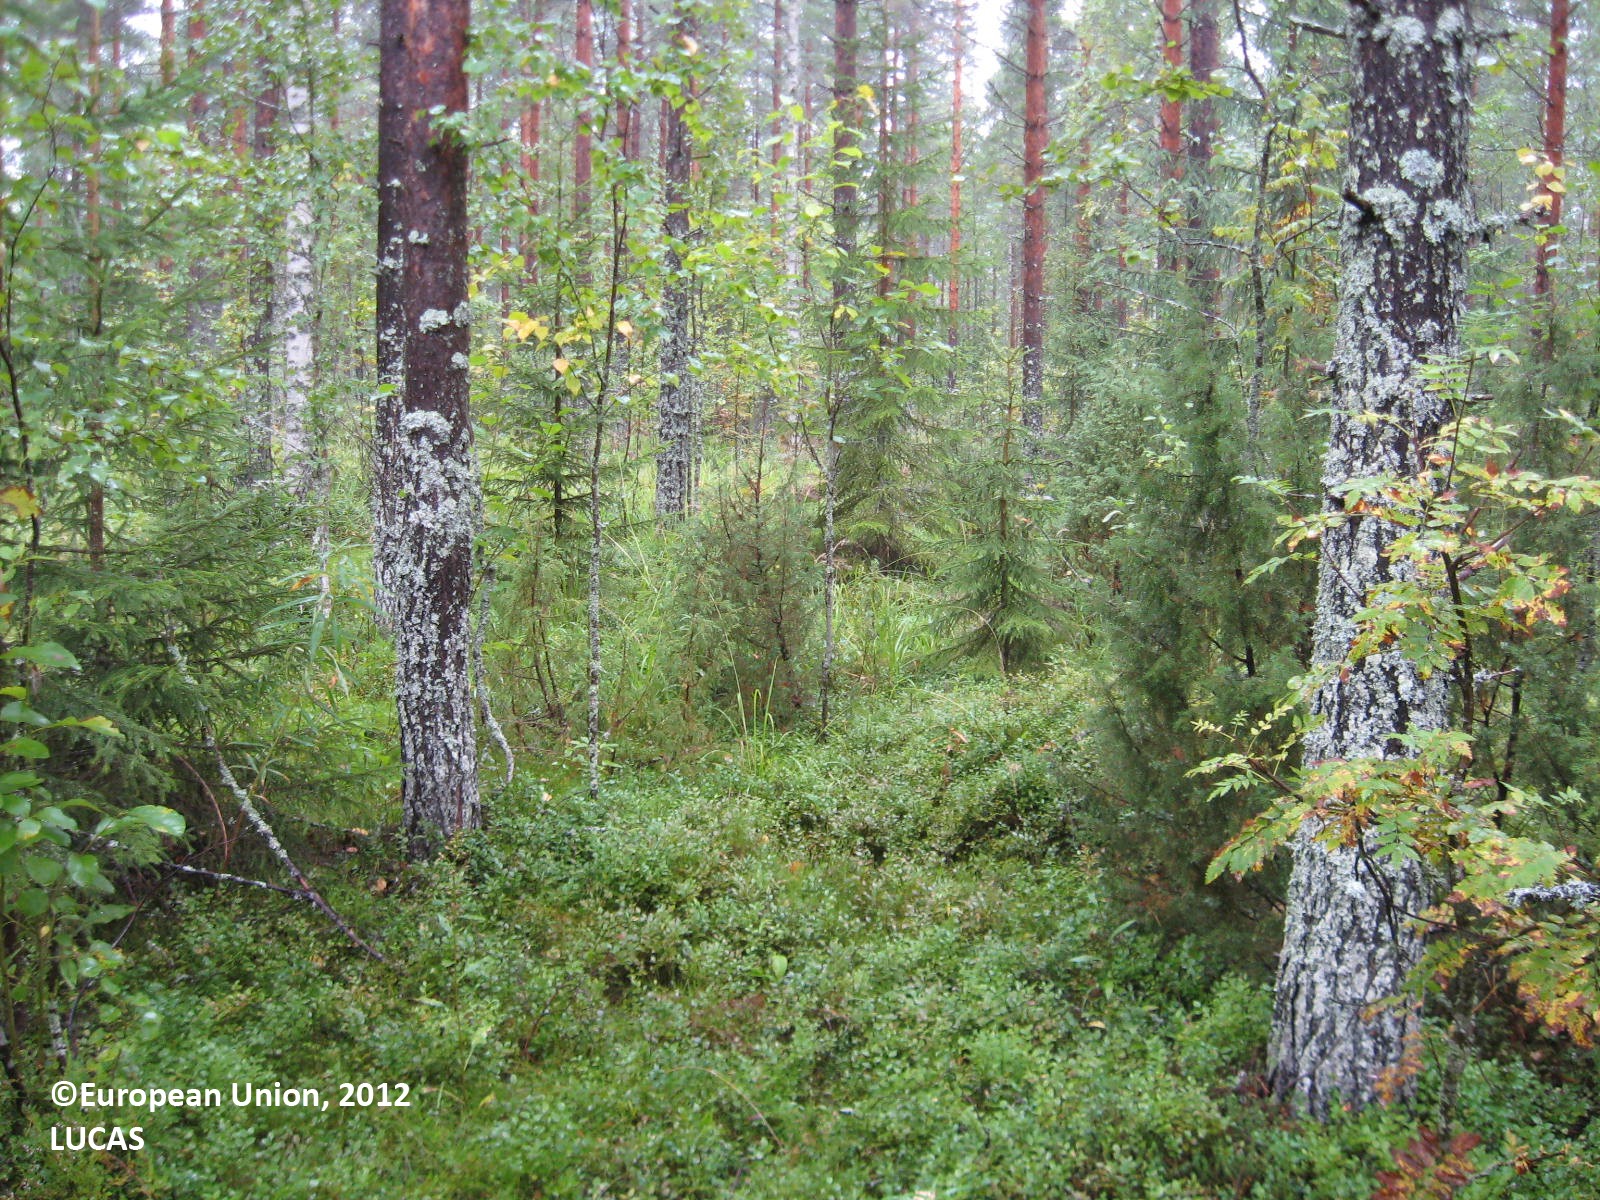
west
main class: Woodland
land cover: Pine dominated coniferous woodland
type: boreal forest
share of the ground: > 75 %
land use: Forestry
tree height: > 5 m
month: August
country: FI
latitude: 63.5671
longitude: 29.4534
